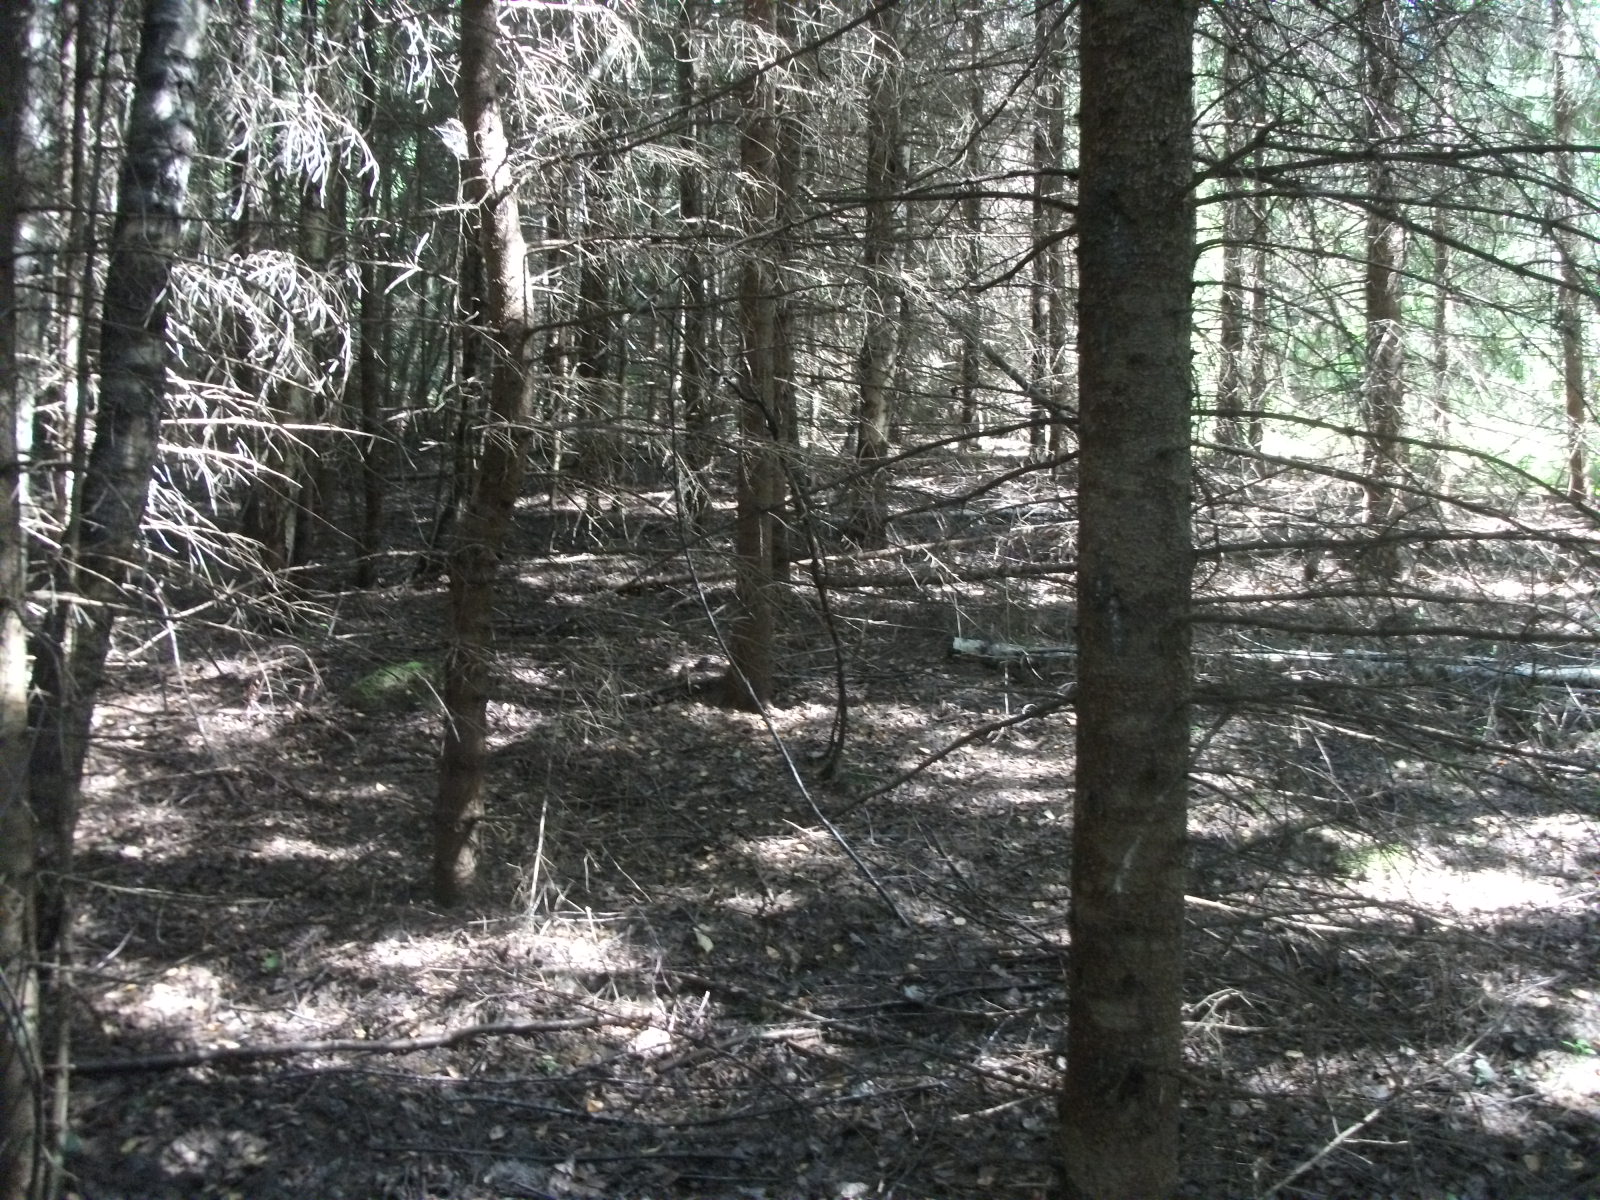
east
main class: Woodland
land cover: Spruce dominated coniferous woodland
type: hemiboreal forest and nemoral coniferous forest and mixed broadleaved-coniferous forest
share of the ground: > 75 %
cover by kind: coniferous forest trees 80 %, unconsolidated bare surface 10 %, broadleaved forest trees 5 %, herbaceous plants 5 %
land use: Forestry
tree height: > 5 m
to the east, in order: Spruce dominated coniferous woodland; Other mixed woodland; Grassland without tree/shrub cover; Grassland with sparse tree/shrub cover; Grassland without tree/shrub cover
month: August
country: LV
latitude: 56.5102
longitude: 26.0432
